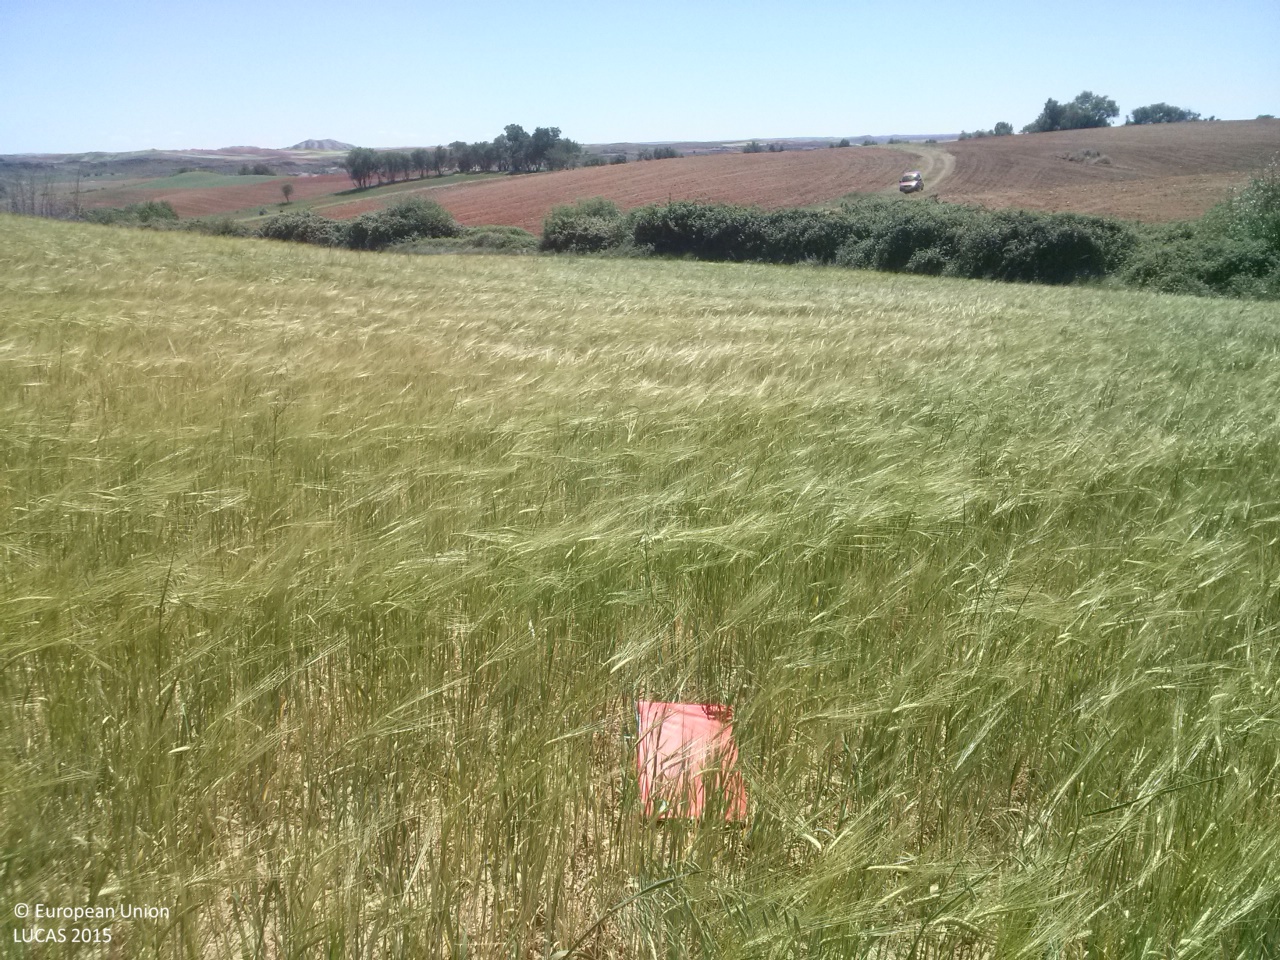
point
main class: Cropland
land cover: Barley
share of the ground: > 75 %
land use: Agriculture (excluding fallow land and kitchen gardens)
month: May
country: ES
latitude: 40.2122
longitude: -2.7960
